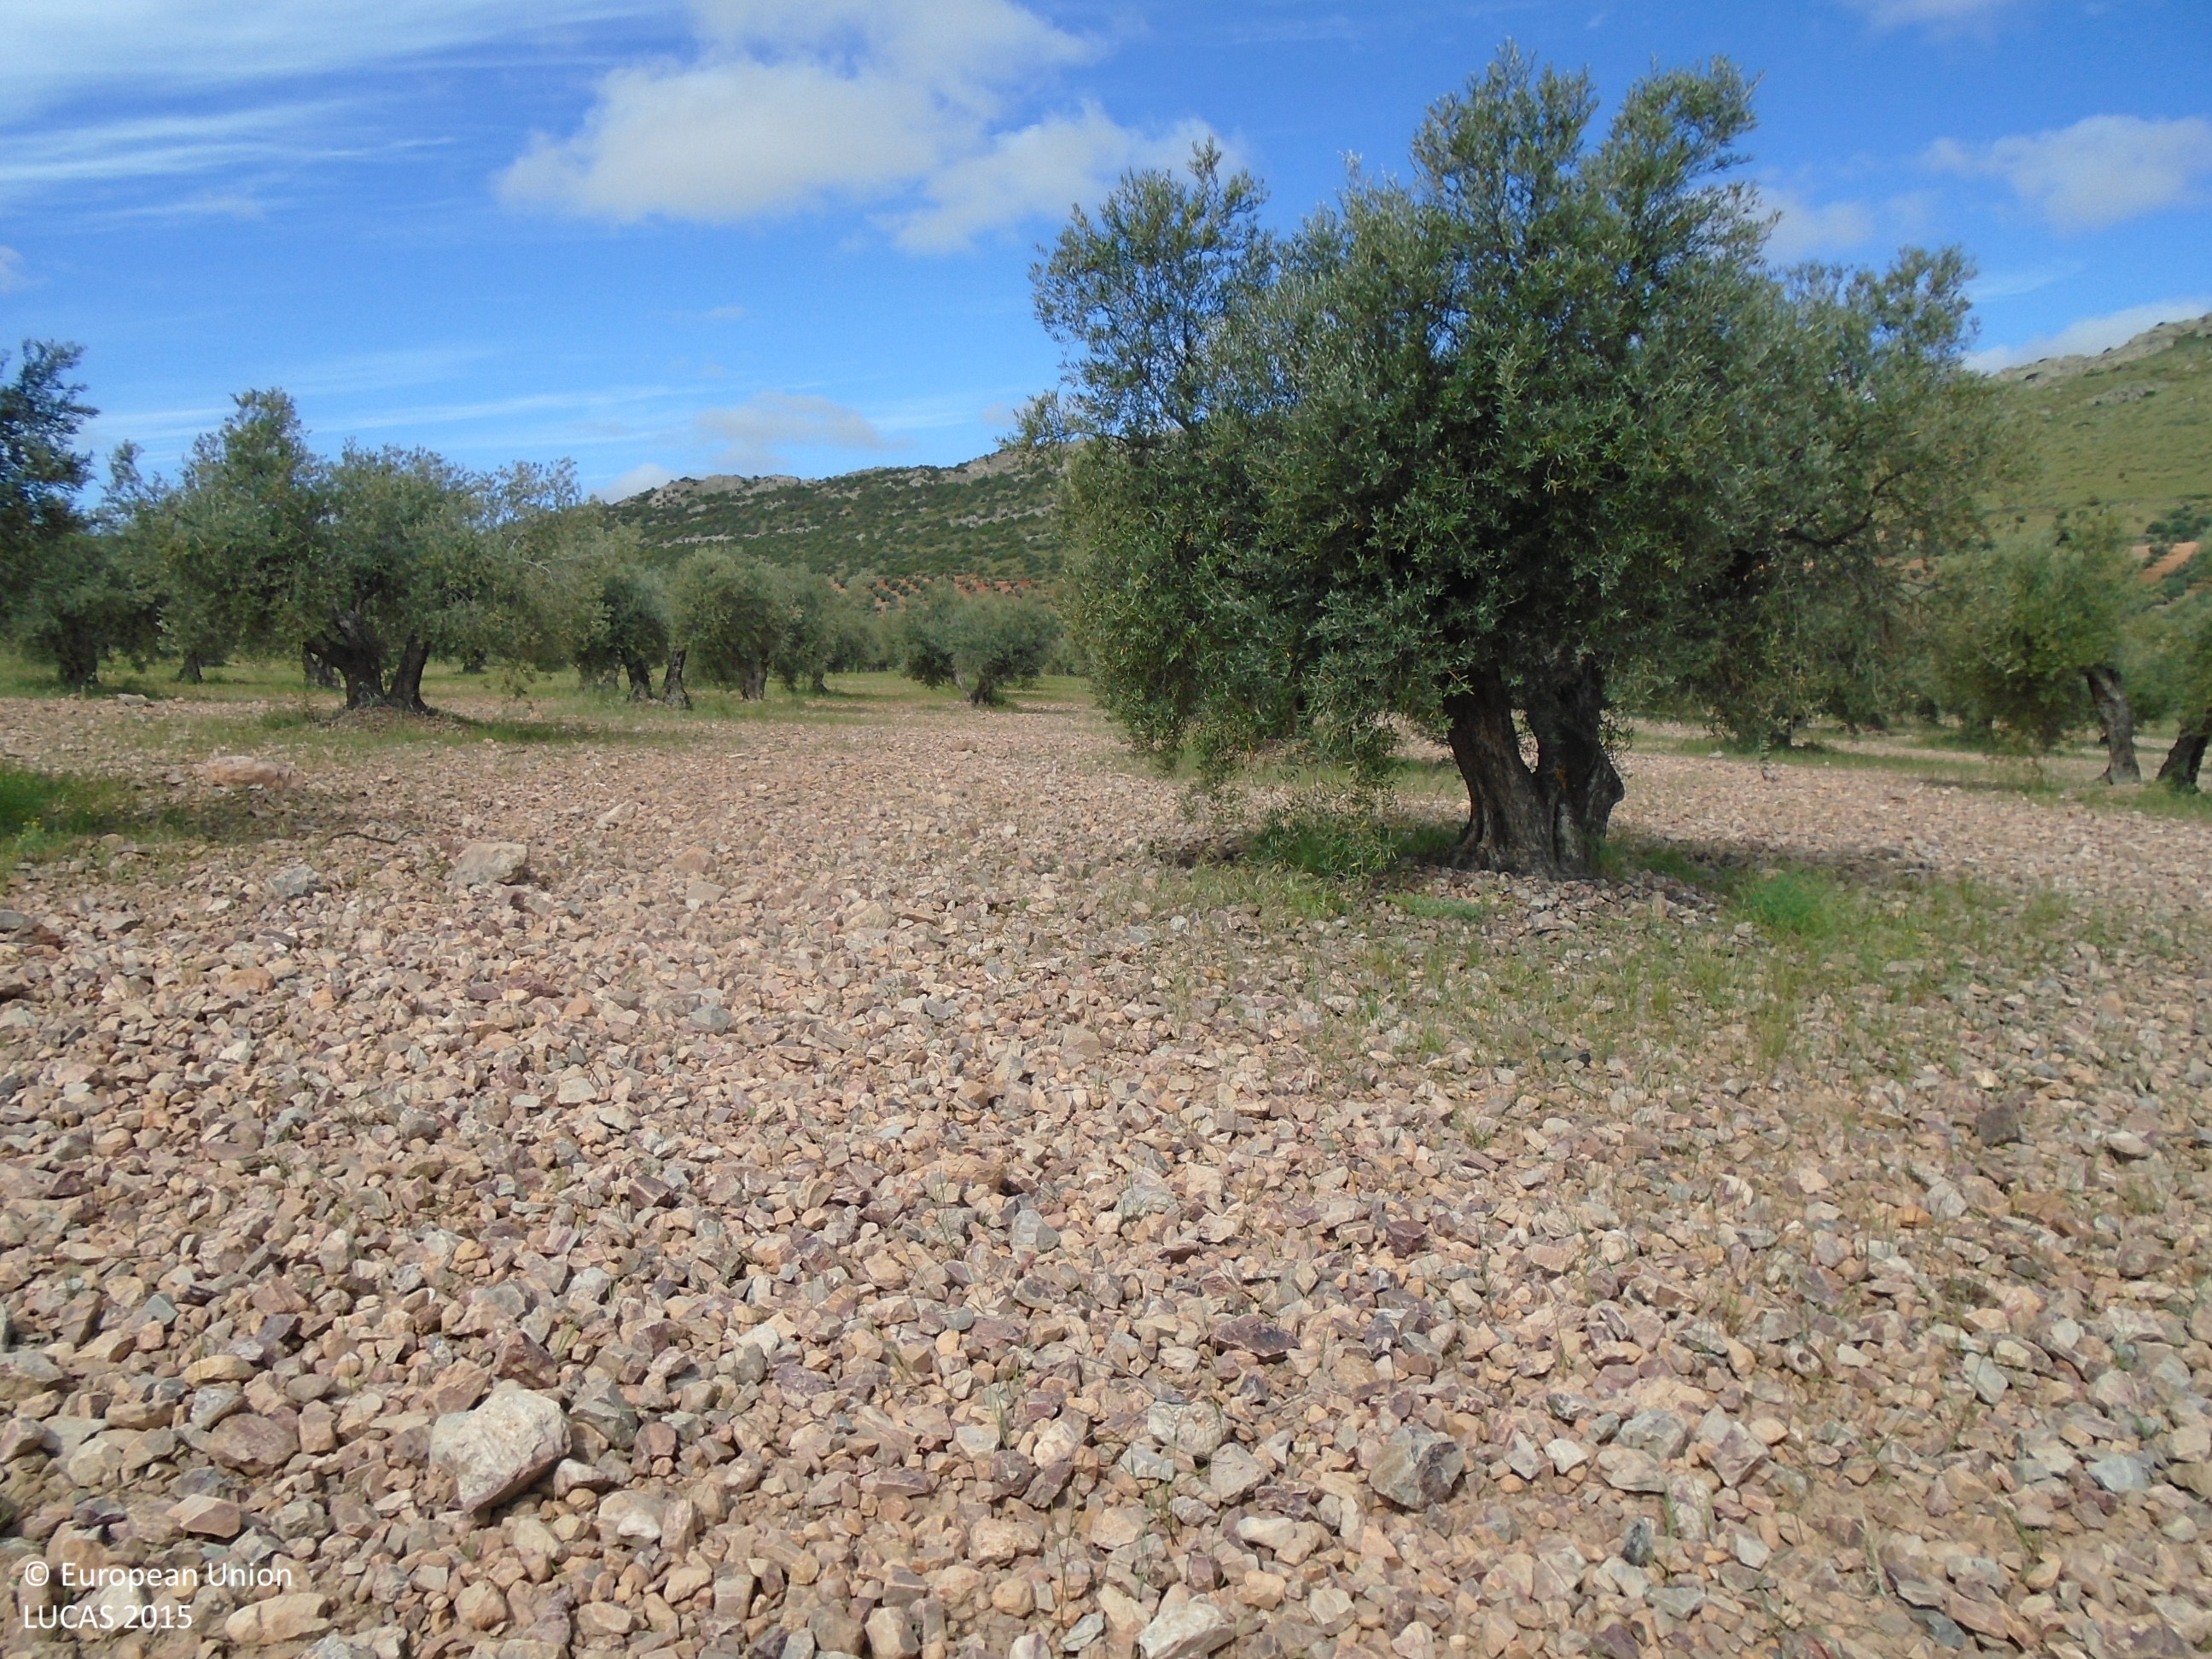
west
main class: Cropland
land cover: Olive groves
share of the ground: 10 - 25 %
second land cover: Spontaneously vegetated surfaces
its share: > 75 %
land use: Agriculture (excluding fallow land and kitchen gardens)
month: May
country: ES
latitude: 39.6643
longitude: -3.7240
